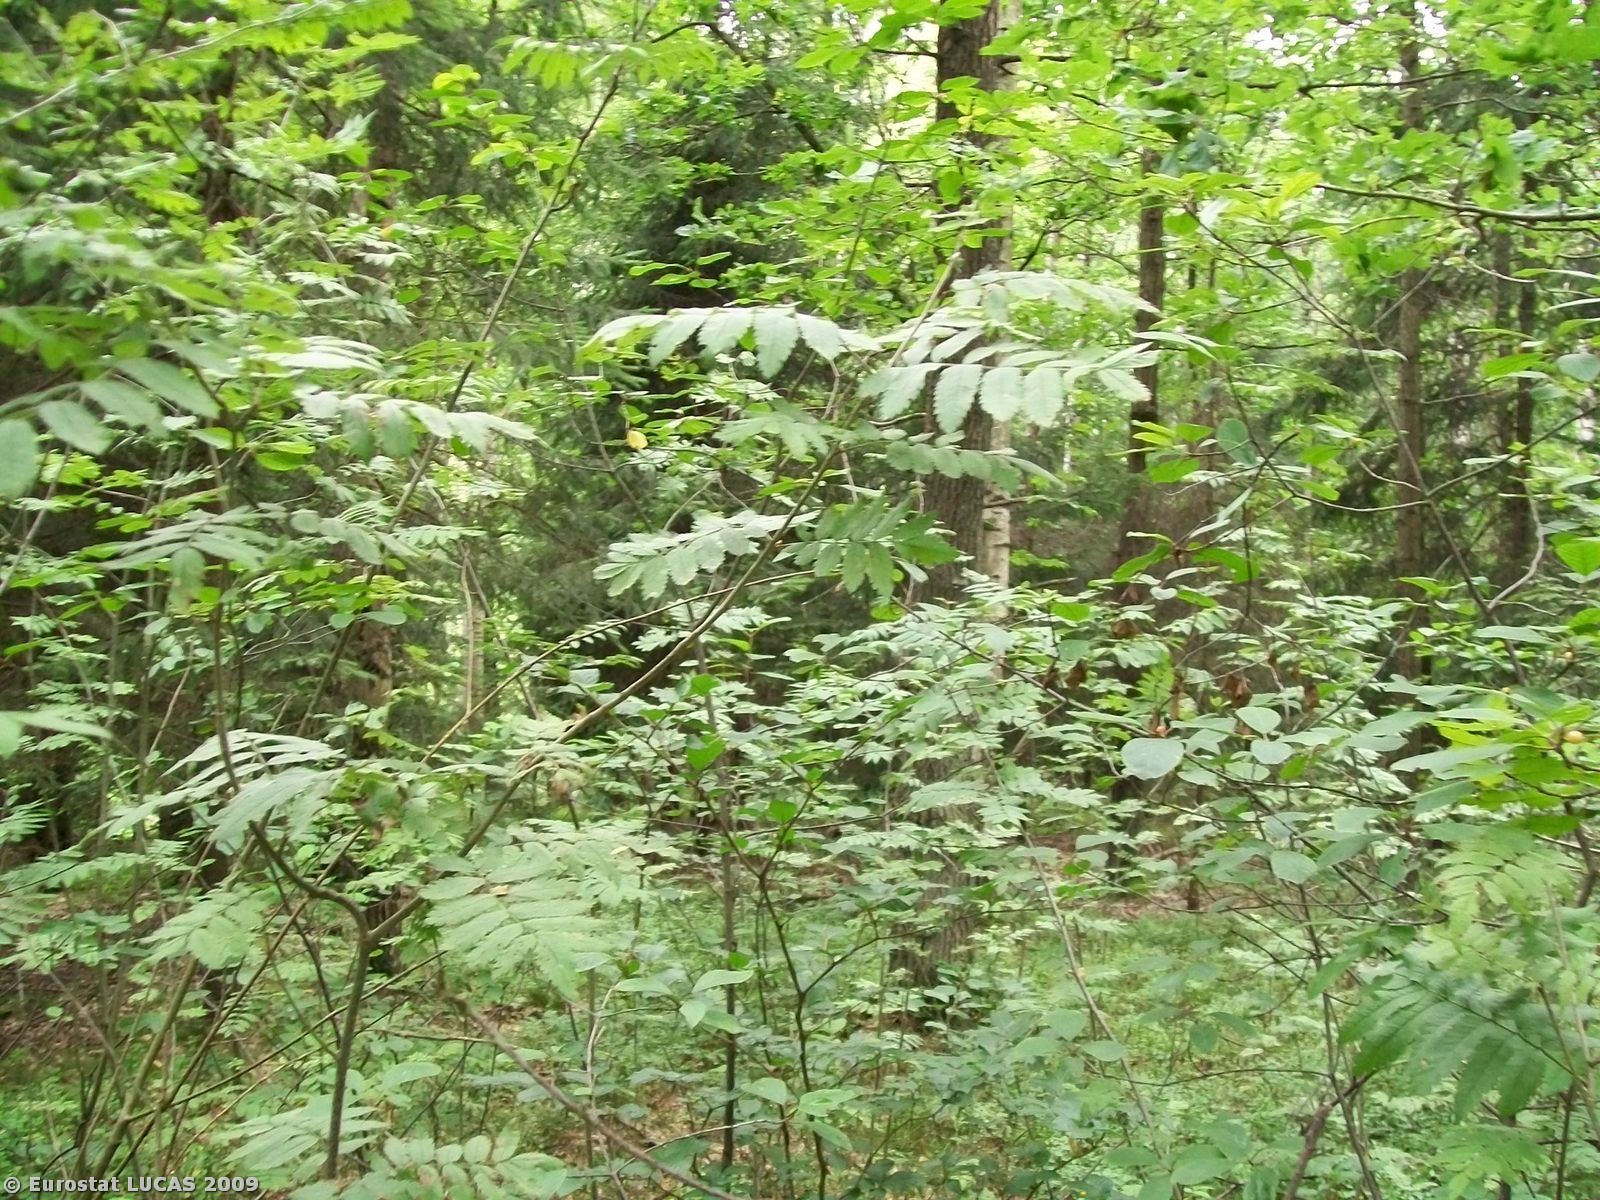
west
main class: Woodland
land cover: Mixed woodland
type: hemiboreal forest and nemoral coniferous forest and mixed broadleaved-coniferous forest
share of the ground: > 75 %
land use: Forestry
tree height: > 5 m
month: July
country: PL
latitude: 51.0228
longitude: 15.1500
